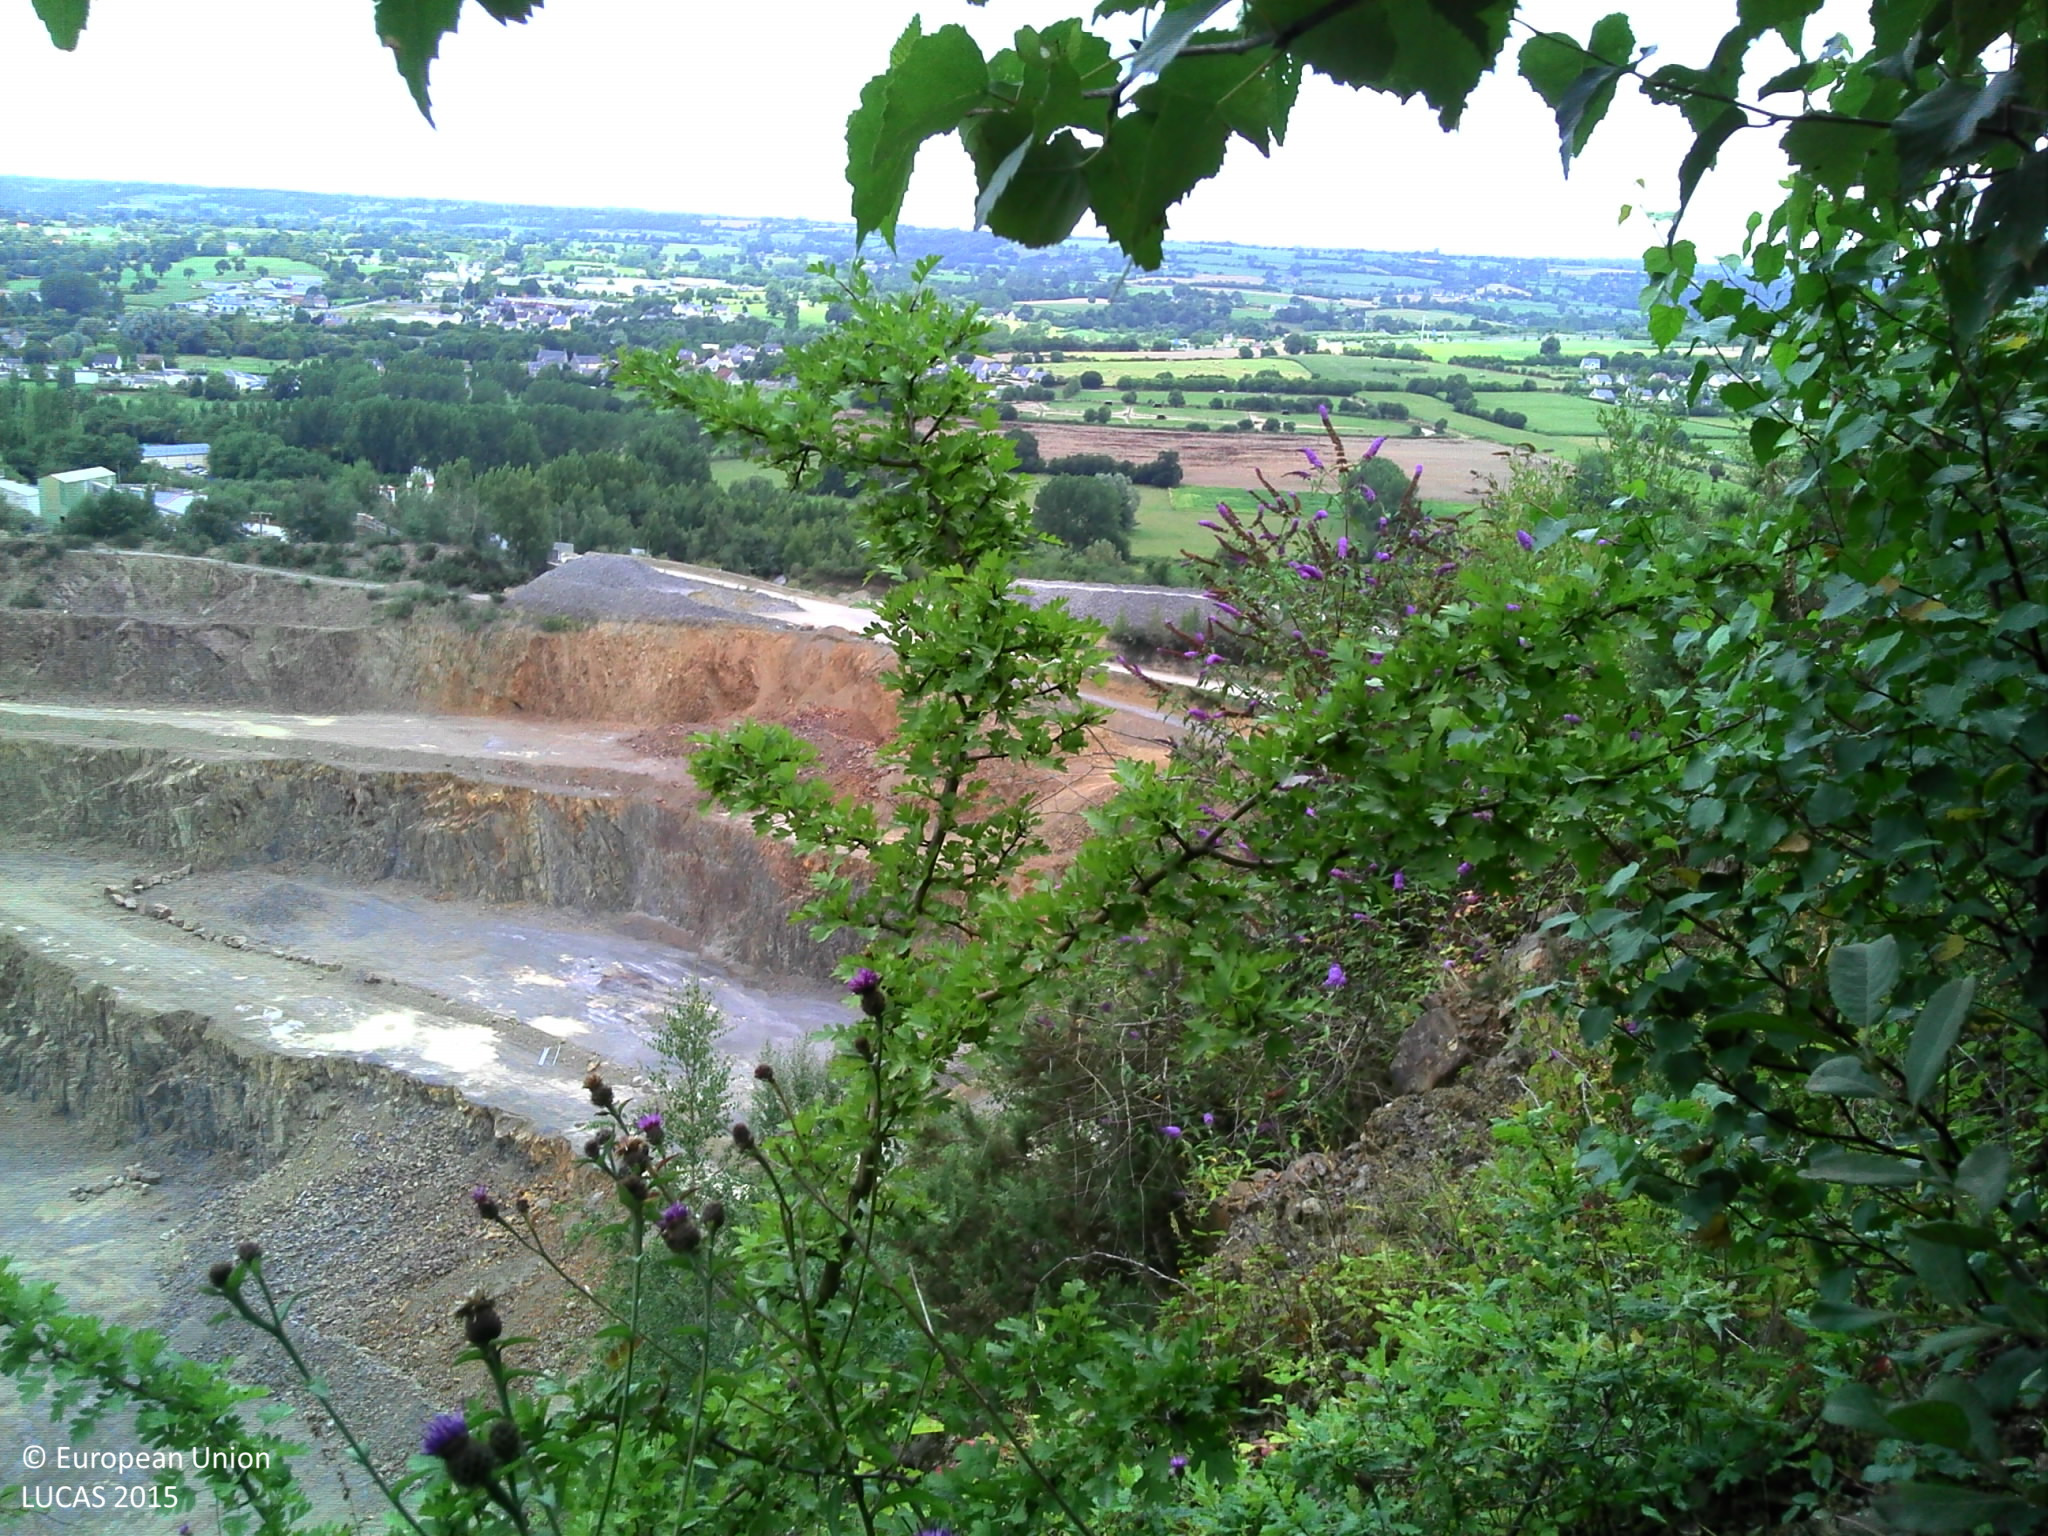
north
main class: Shrubland
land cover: Shrubland without tree cover
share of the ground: > 75 %
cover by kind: shrubs 50 %, herbaceous plants 50 %
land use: Semi-natural and natural areas not in use
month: August
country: FR
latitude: 48.6906
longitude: -1.3344
